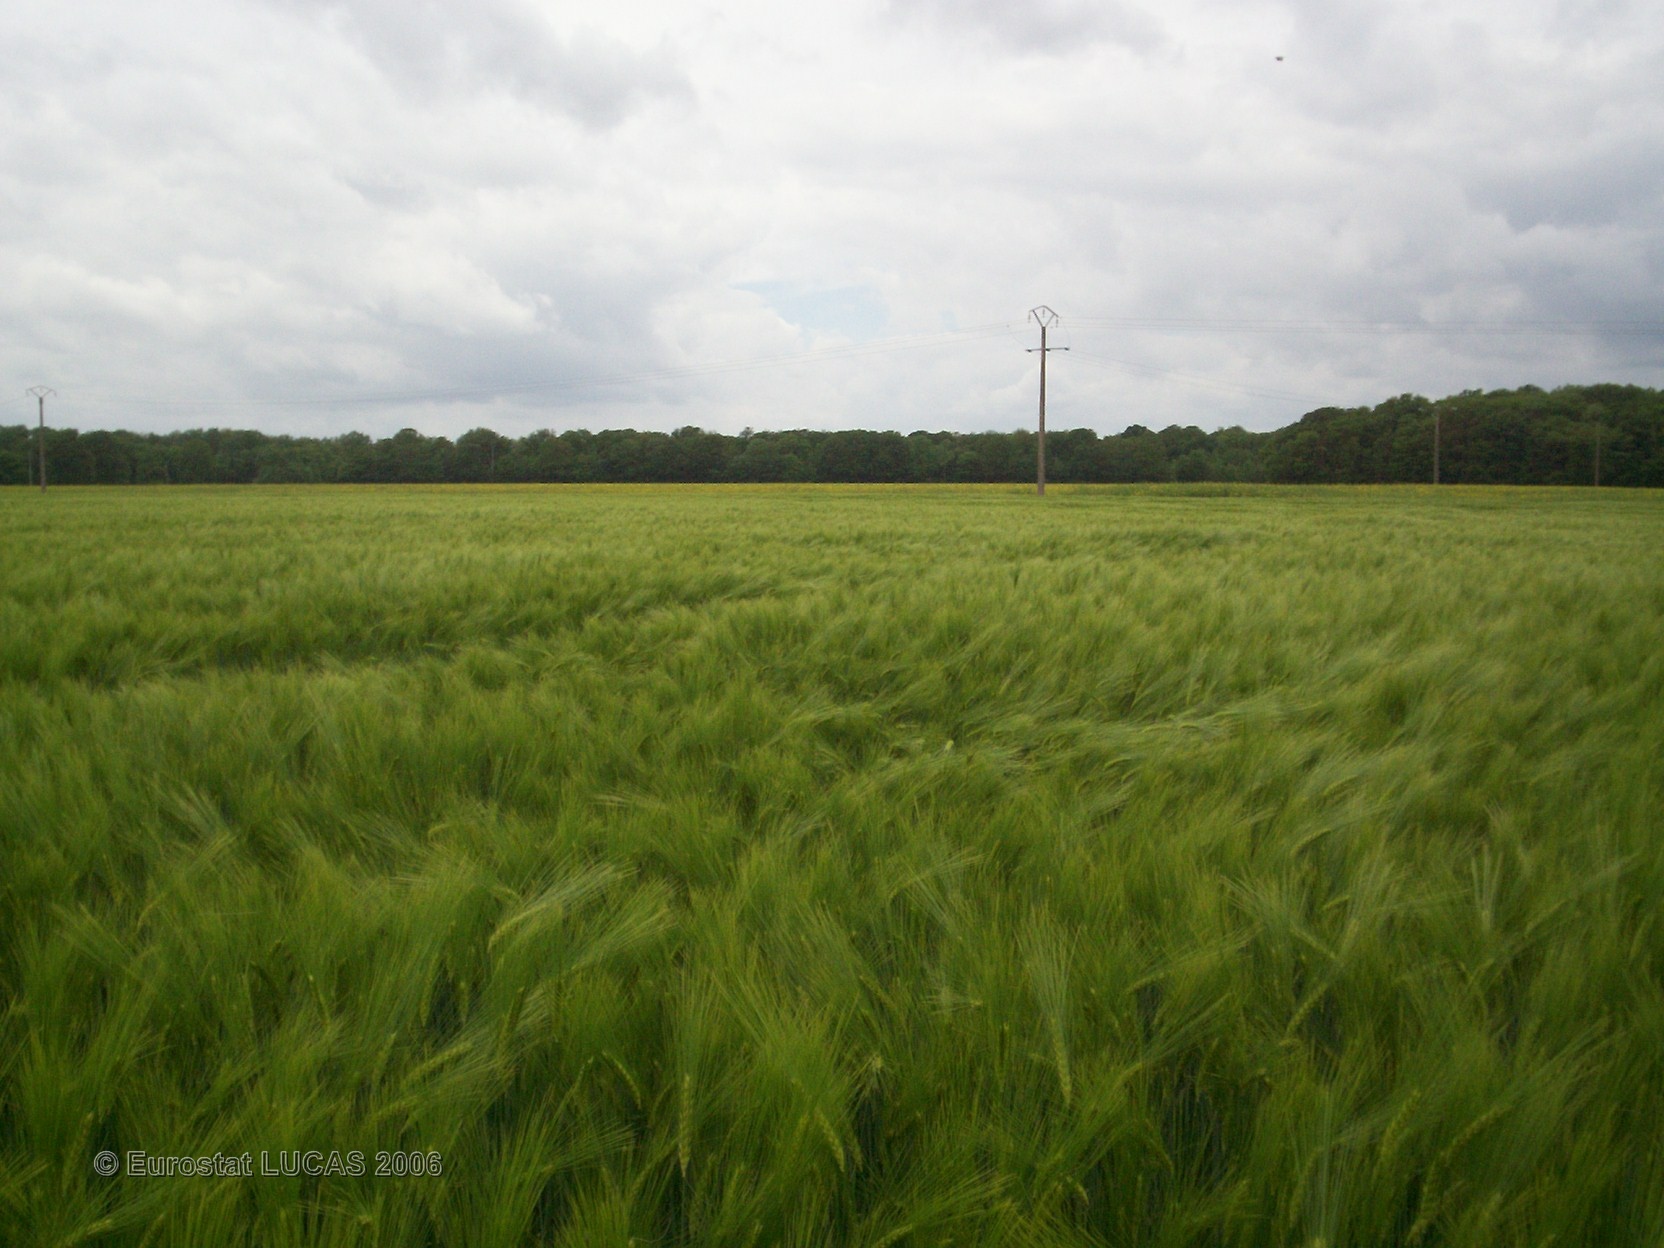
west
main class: Cropland
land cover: Common wheat
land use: Agriculture (excluding fallow land and kitchen gardens)
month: May
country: FR
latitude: 48.6945
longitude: 2.8310
